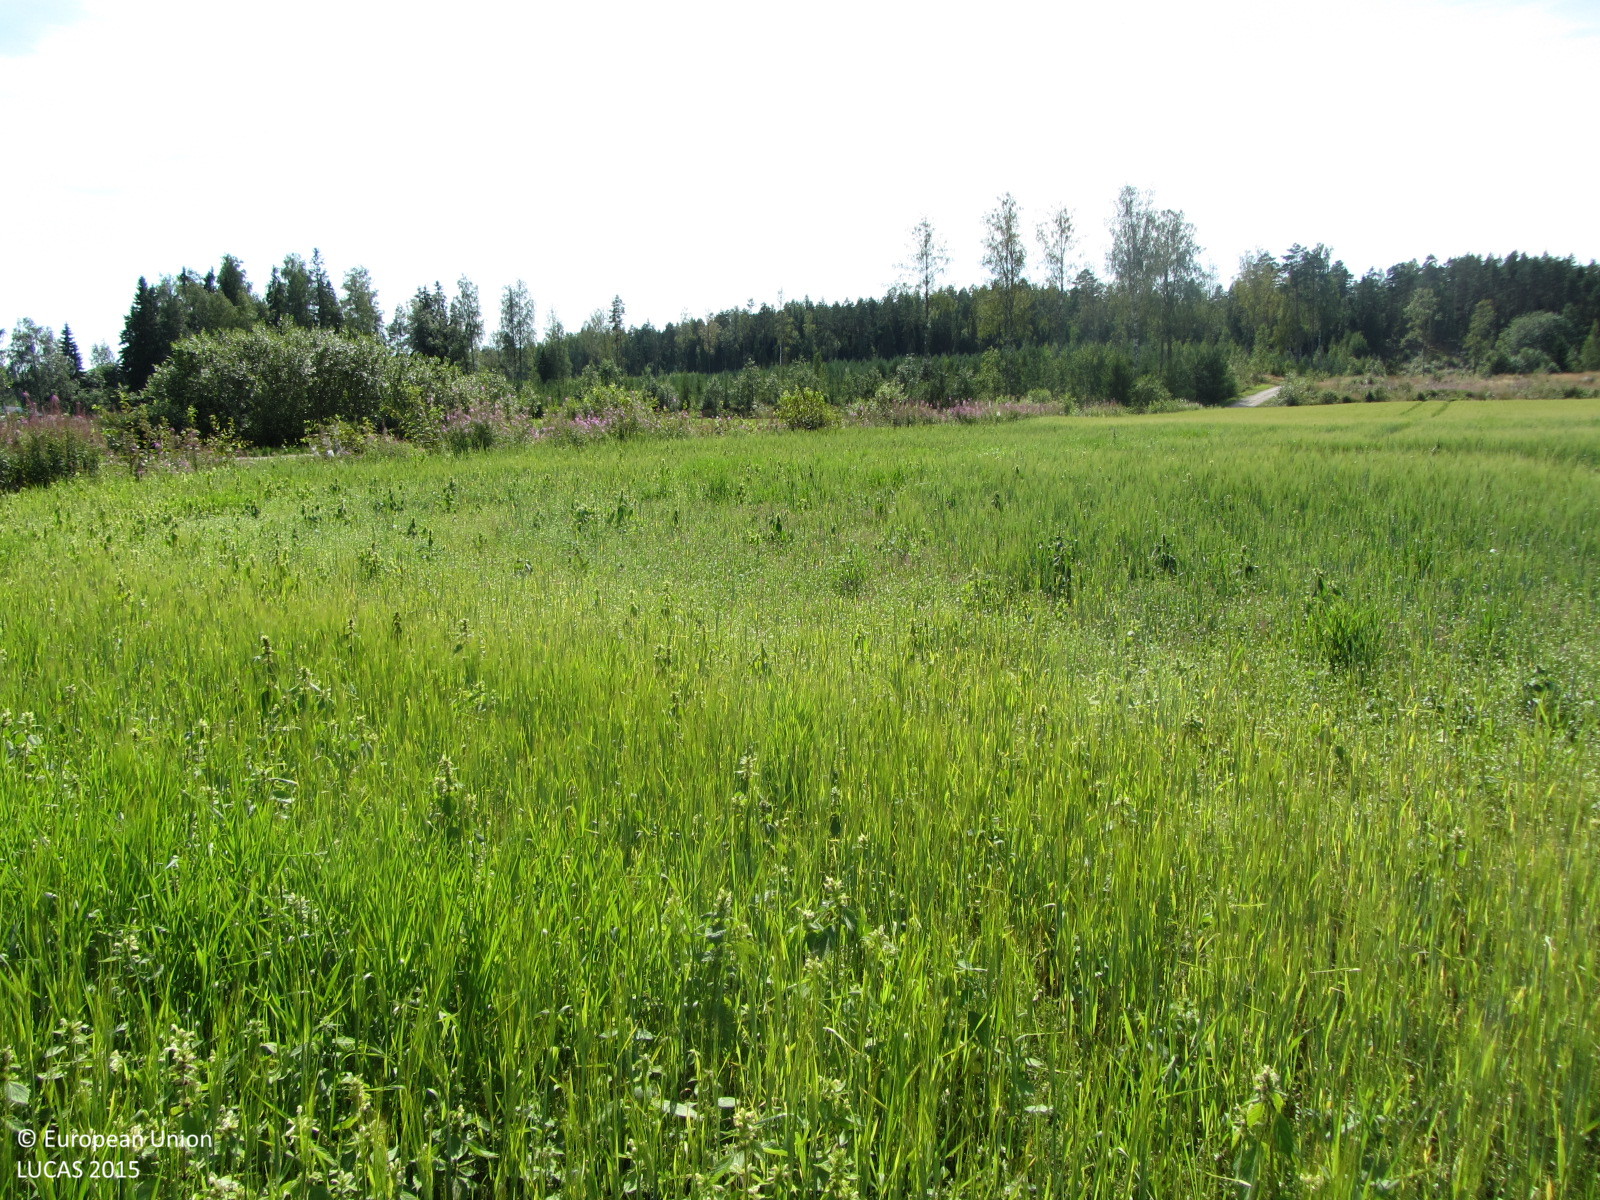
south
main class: Cropland
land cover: Barley
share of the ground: > 75 %
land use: Agriculture (excluding fallow land and kitchen gardens)
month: August
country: FI
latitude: 60.4657
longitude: 23.4530
